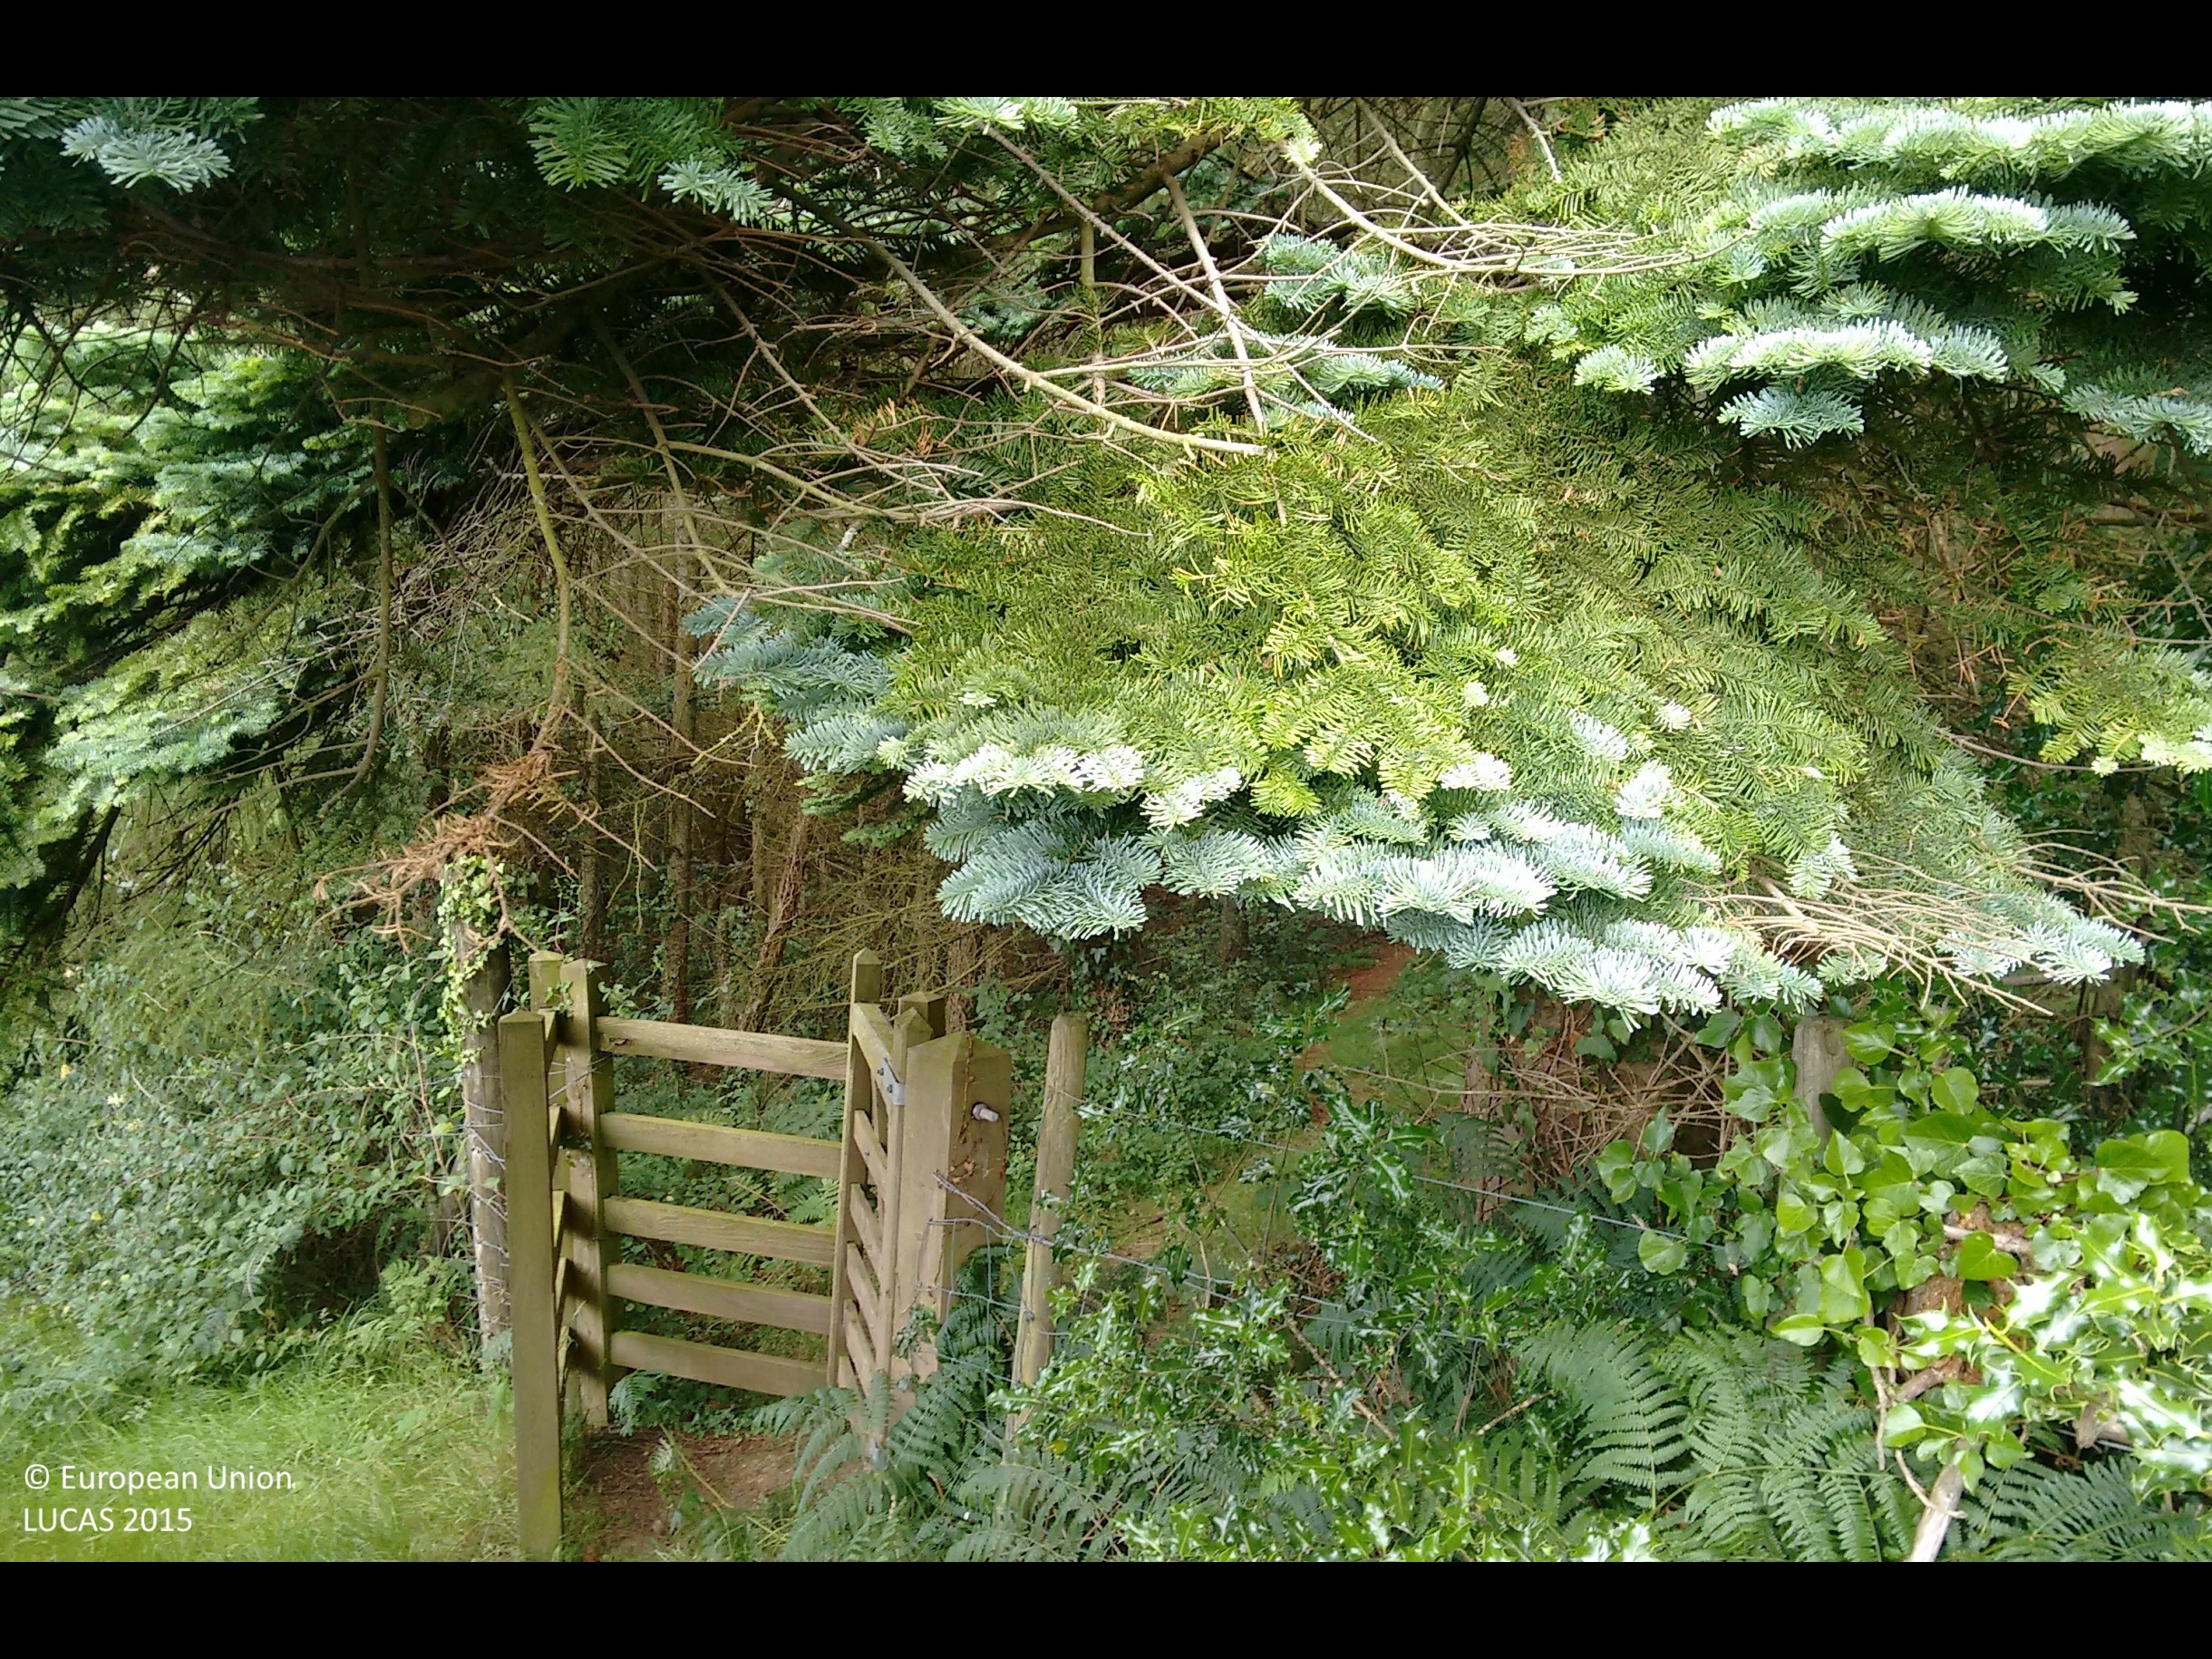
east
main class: Woodland
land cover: Other coniferous woodland
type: exotic forest
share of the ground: > 75 %
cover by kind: coniferous forest trees 100 %
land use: Forestry
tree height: > 5 m
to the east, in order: Other coniferous woodland; Pine dominated coniferous woodland
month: August
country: GB
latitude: 53.2919
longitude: -4.1849
